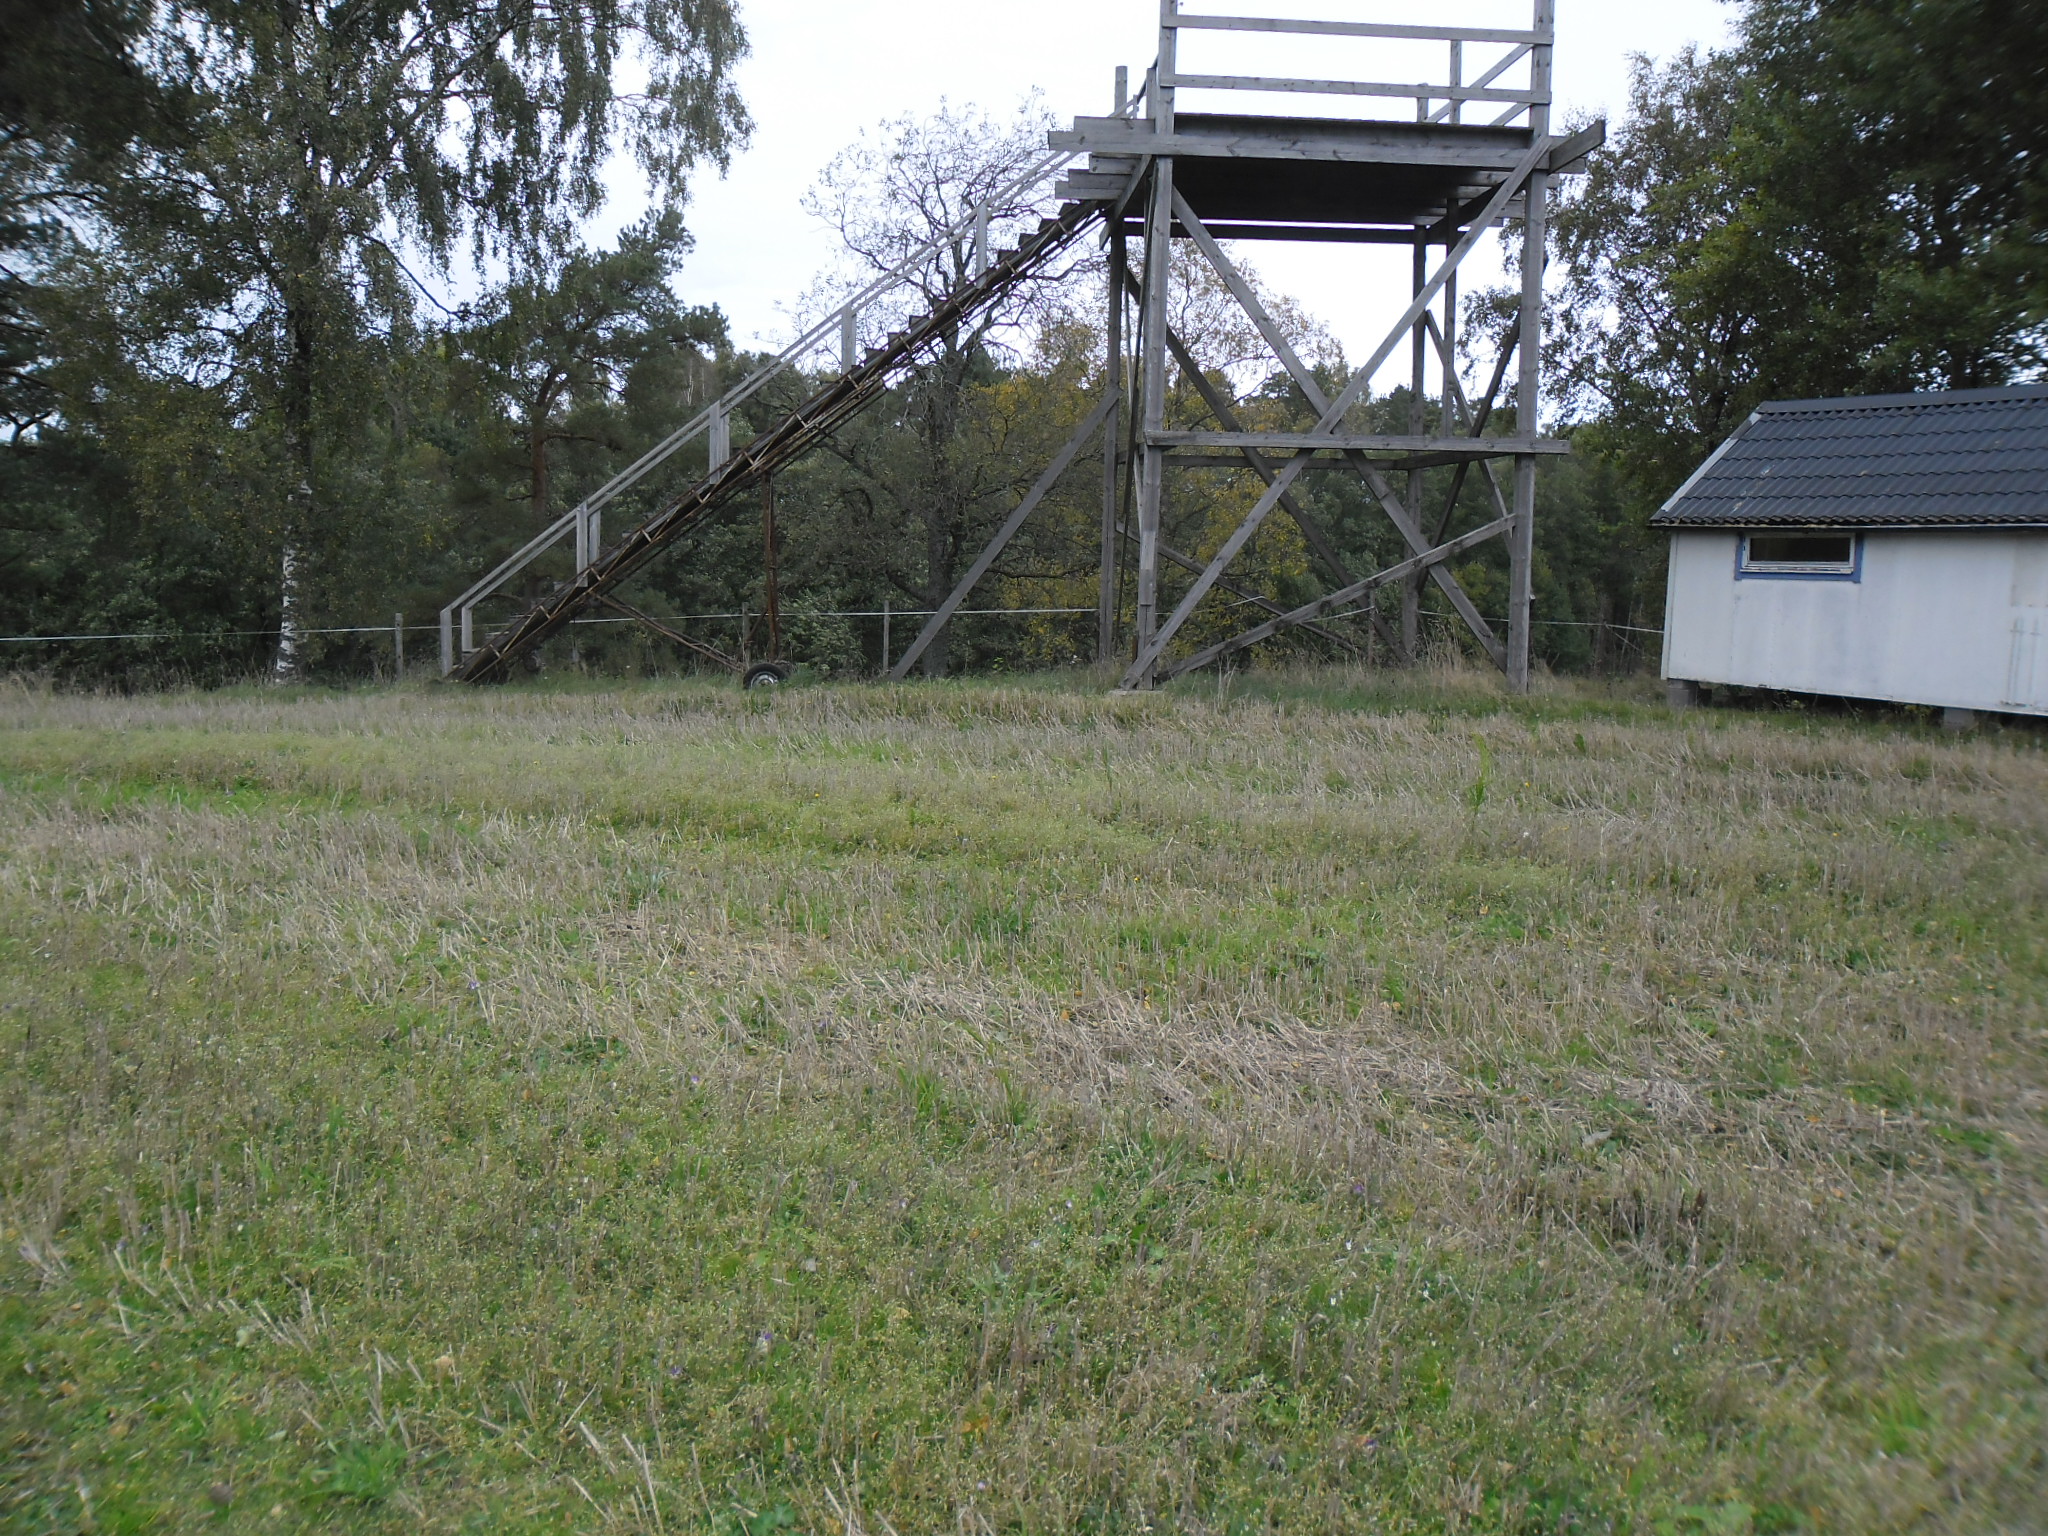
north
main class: Cropland
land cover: Common wheat
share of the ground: < 10 %
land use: Agriculture (excluding fallow land and kitchen gardens)
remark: Harvested field
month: October
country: SE
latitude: 56.5812
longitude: 13.1390
